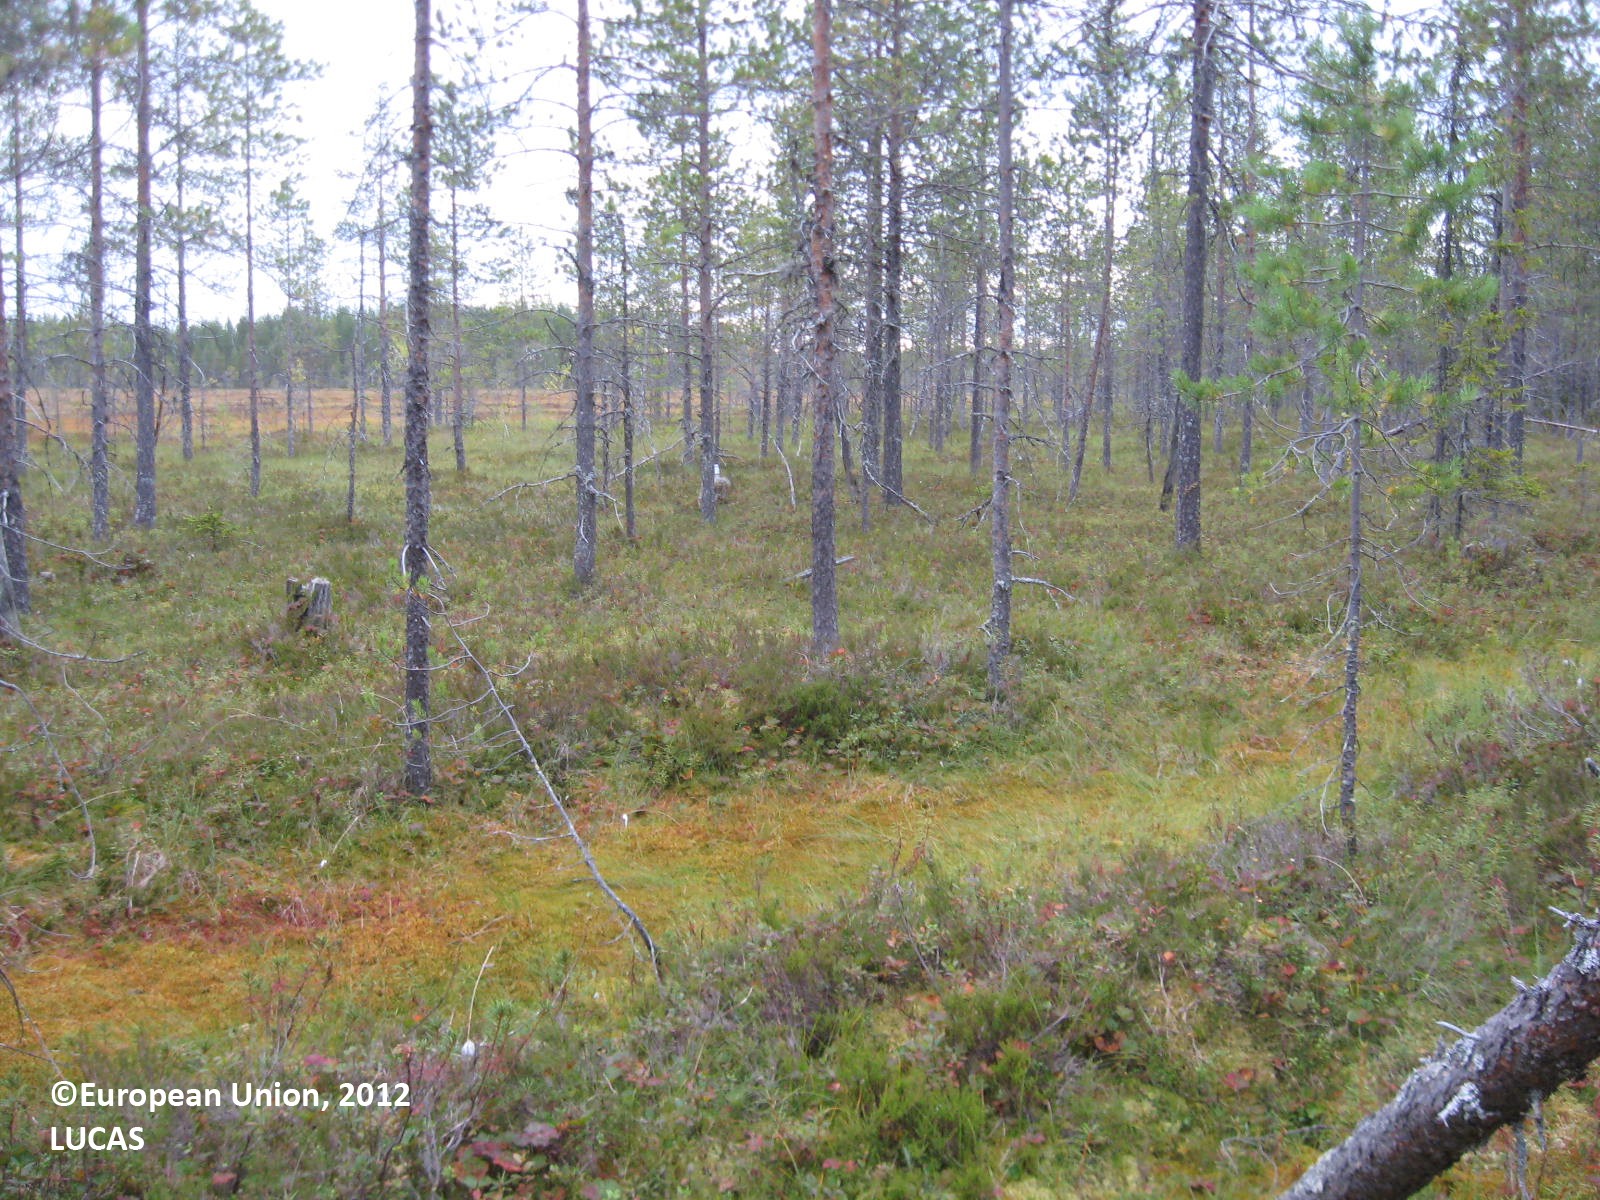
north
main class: Woodland
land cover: Pine dominated coniferous woodland
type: boreal forest
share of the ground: 50 - 75 %
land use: Semi-natural and natural areas not in use
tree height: > 5 m
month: August
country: FI
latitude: 63.7242
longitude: 29.6888
